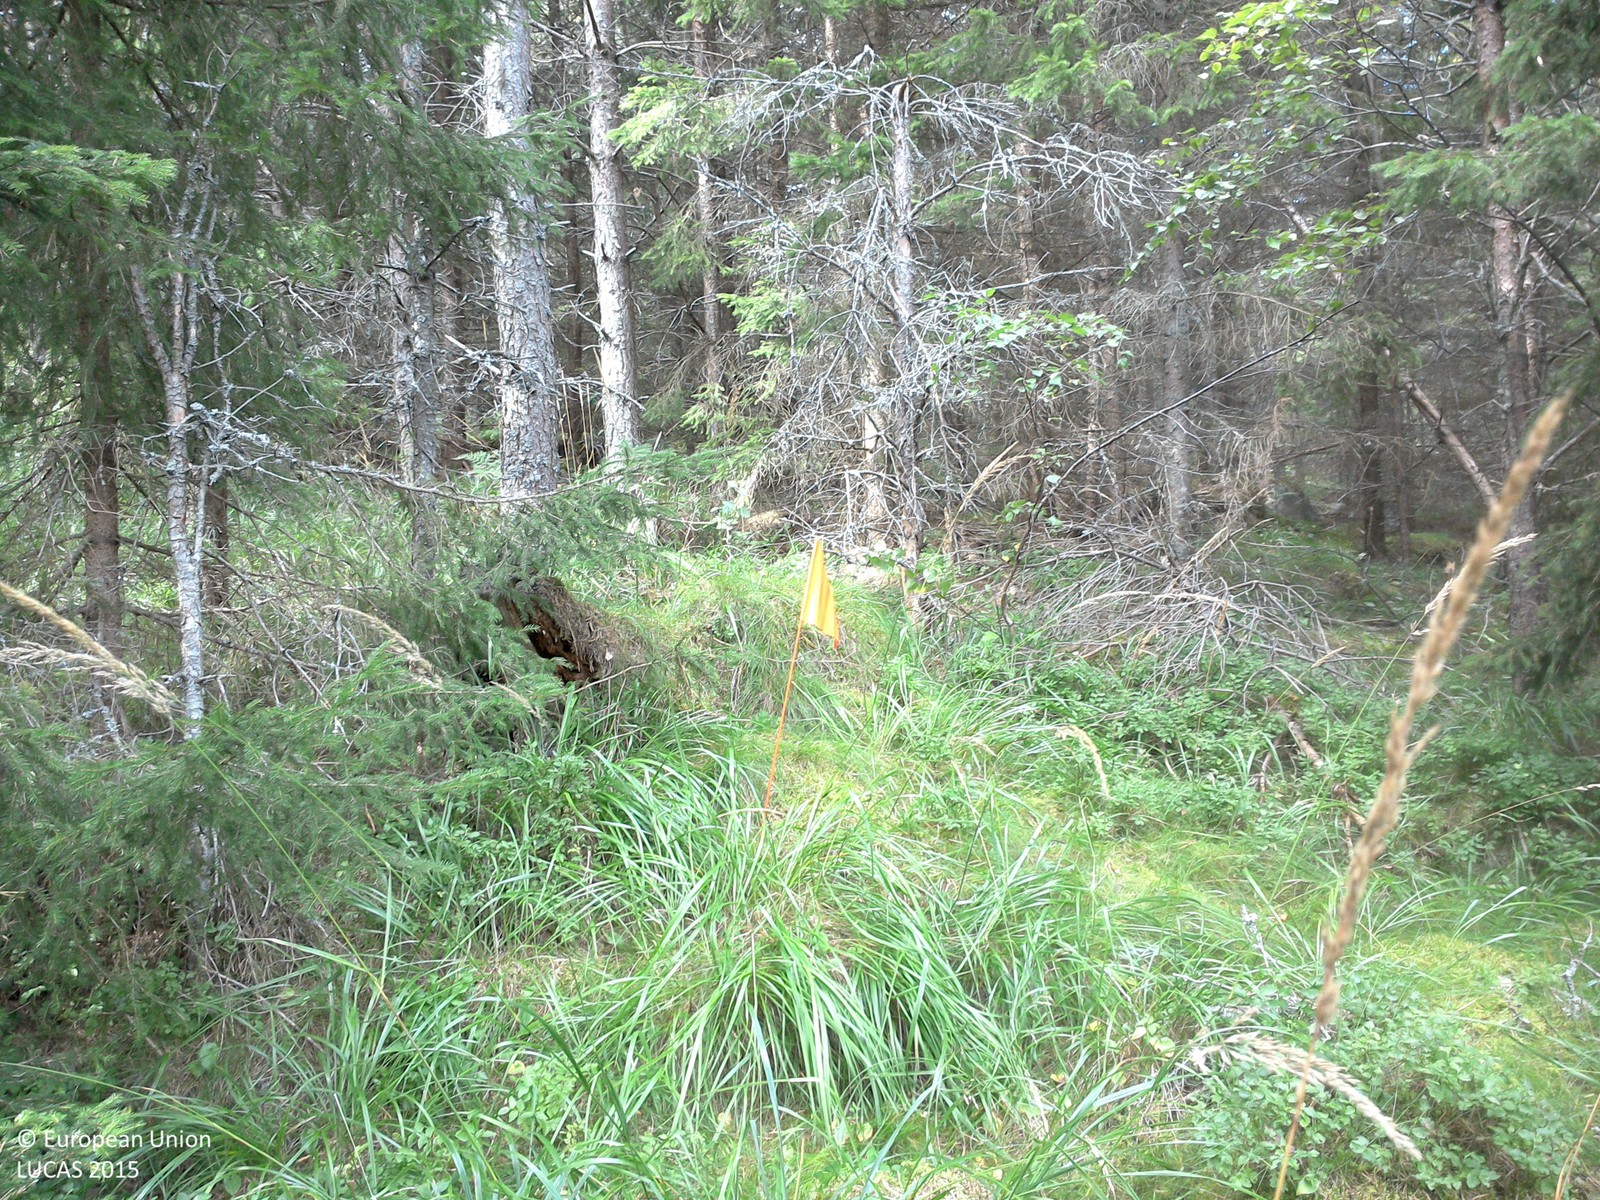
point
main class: Woodland
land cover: Pine dominated mixed woodland
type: boreal forest
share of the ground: 50 - 75 %
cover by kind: coniferous forest trees 50 %, broadleaved forest trees 20 %, herbaceous plants 20 %, lichens and mosses 10 %
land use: Forestry
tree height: > 5 m
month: August
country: SE
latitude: 57.9053
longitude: 15.5814
